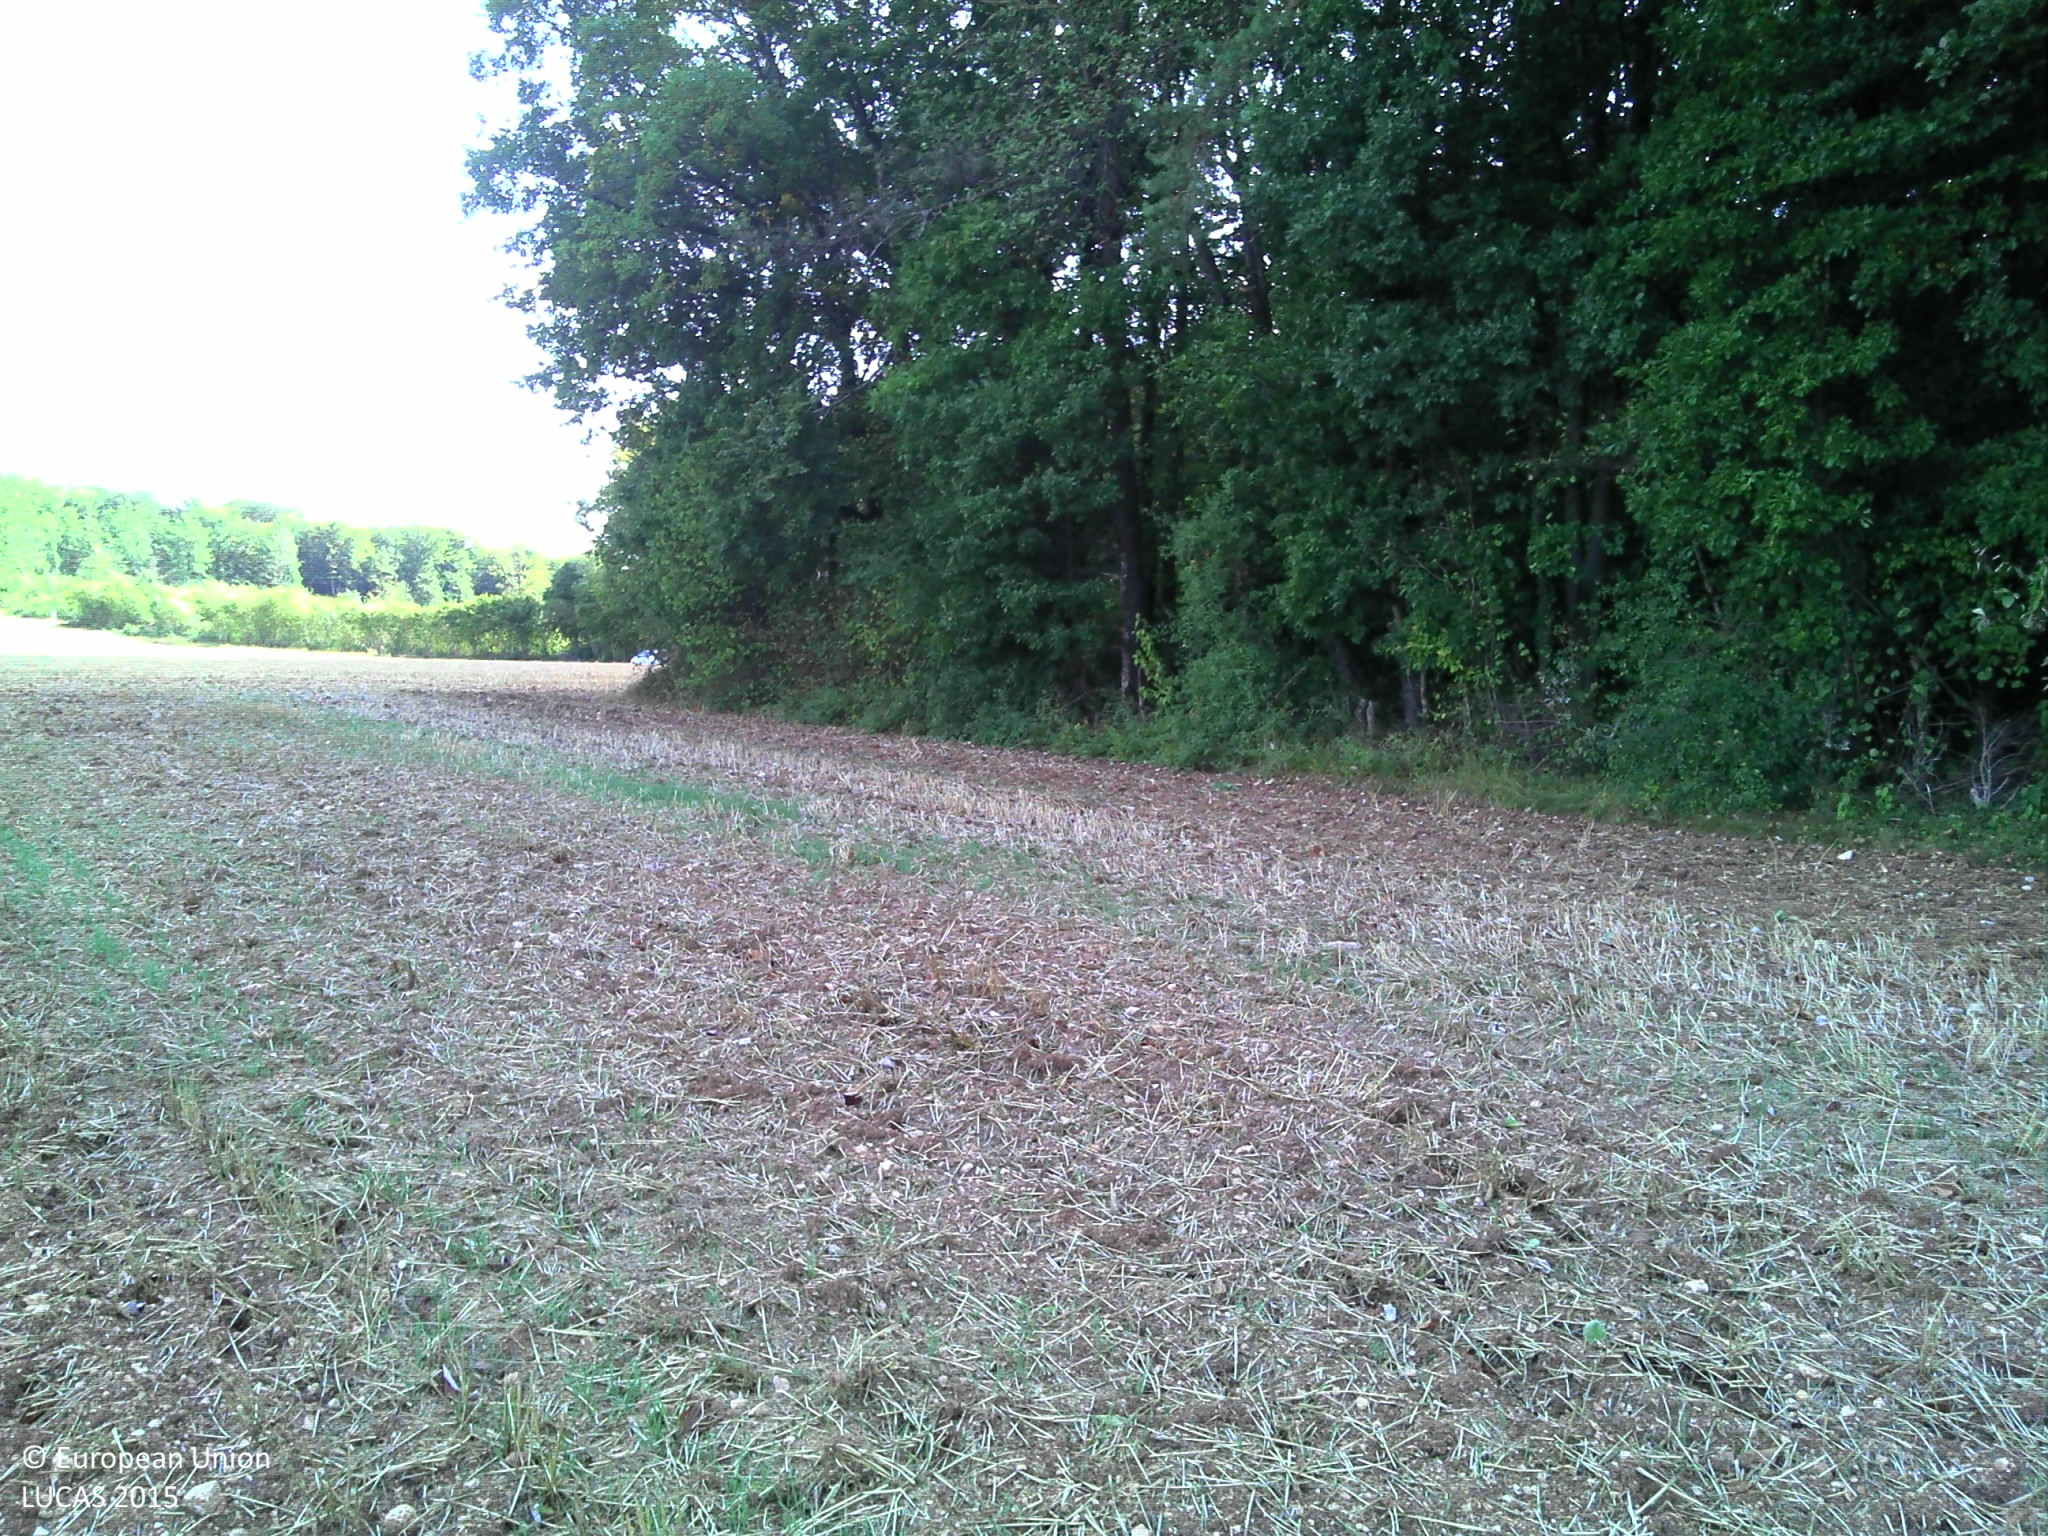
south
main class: Cropland
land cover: Common wheat
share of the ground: > 75 %
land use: Agriculture (excluding fallow land and kitchen gardens)
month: August
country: FR
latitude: 47.7816
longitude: 4.9144
